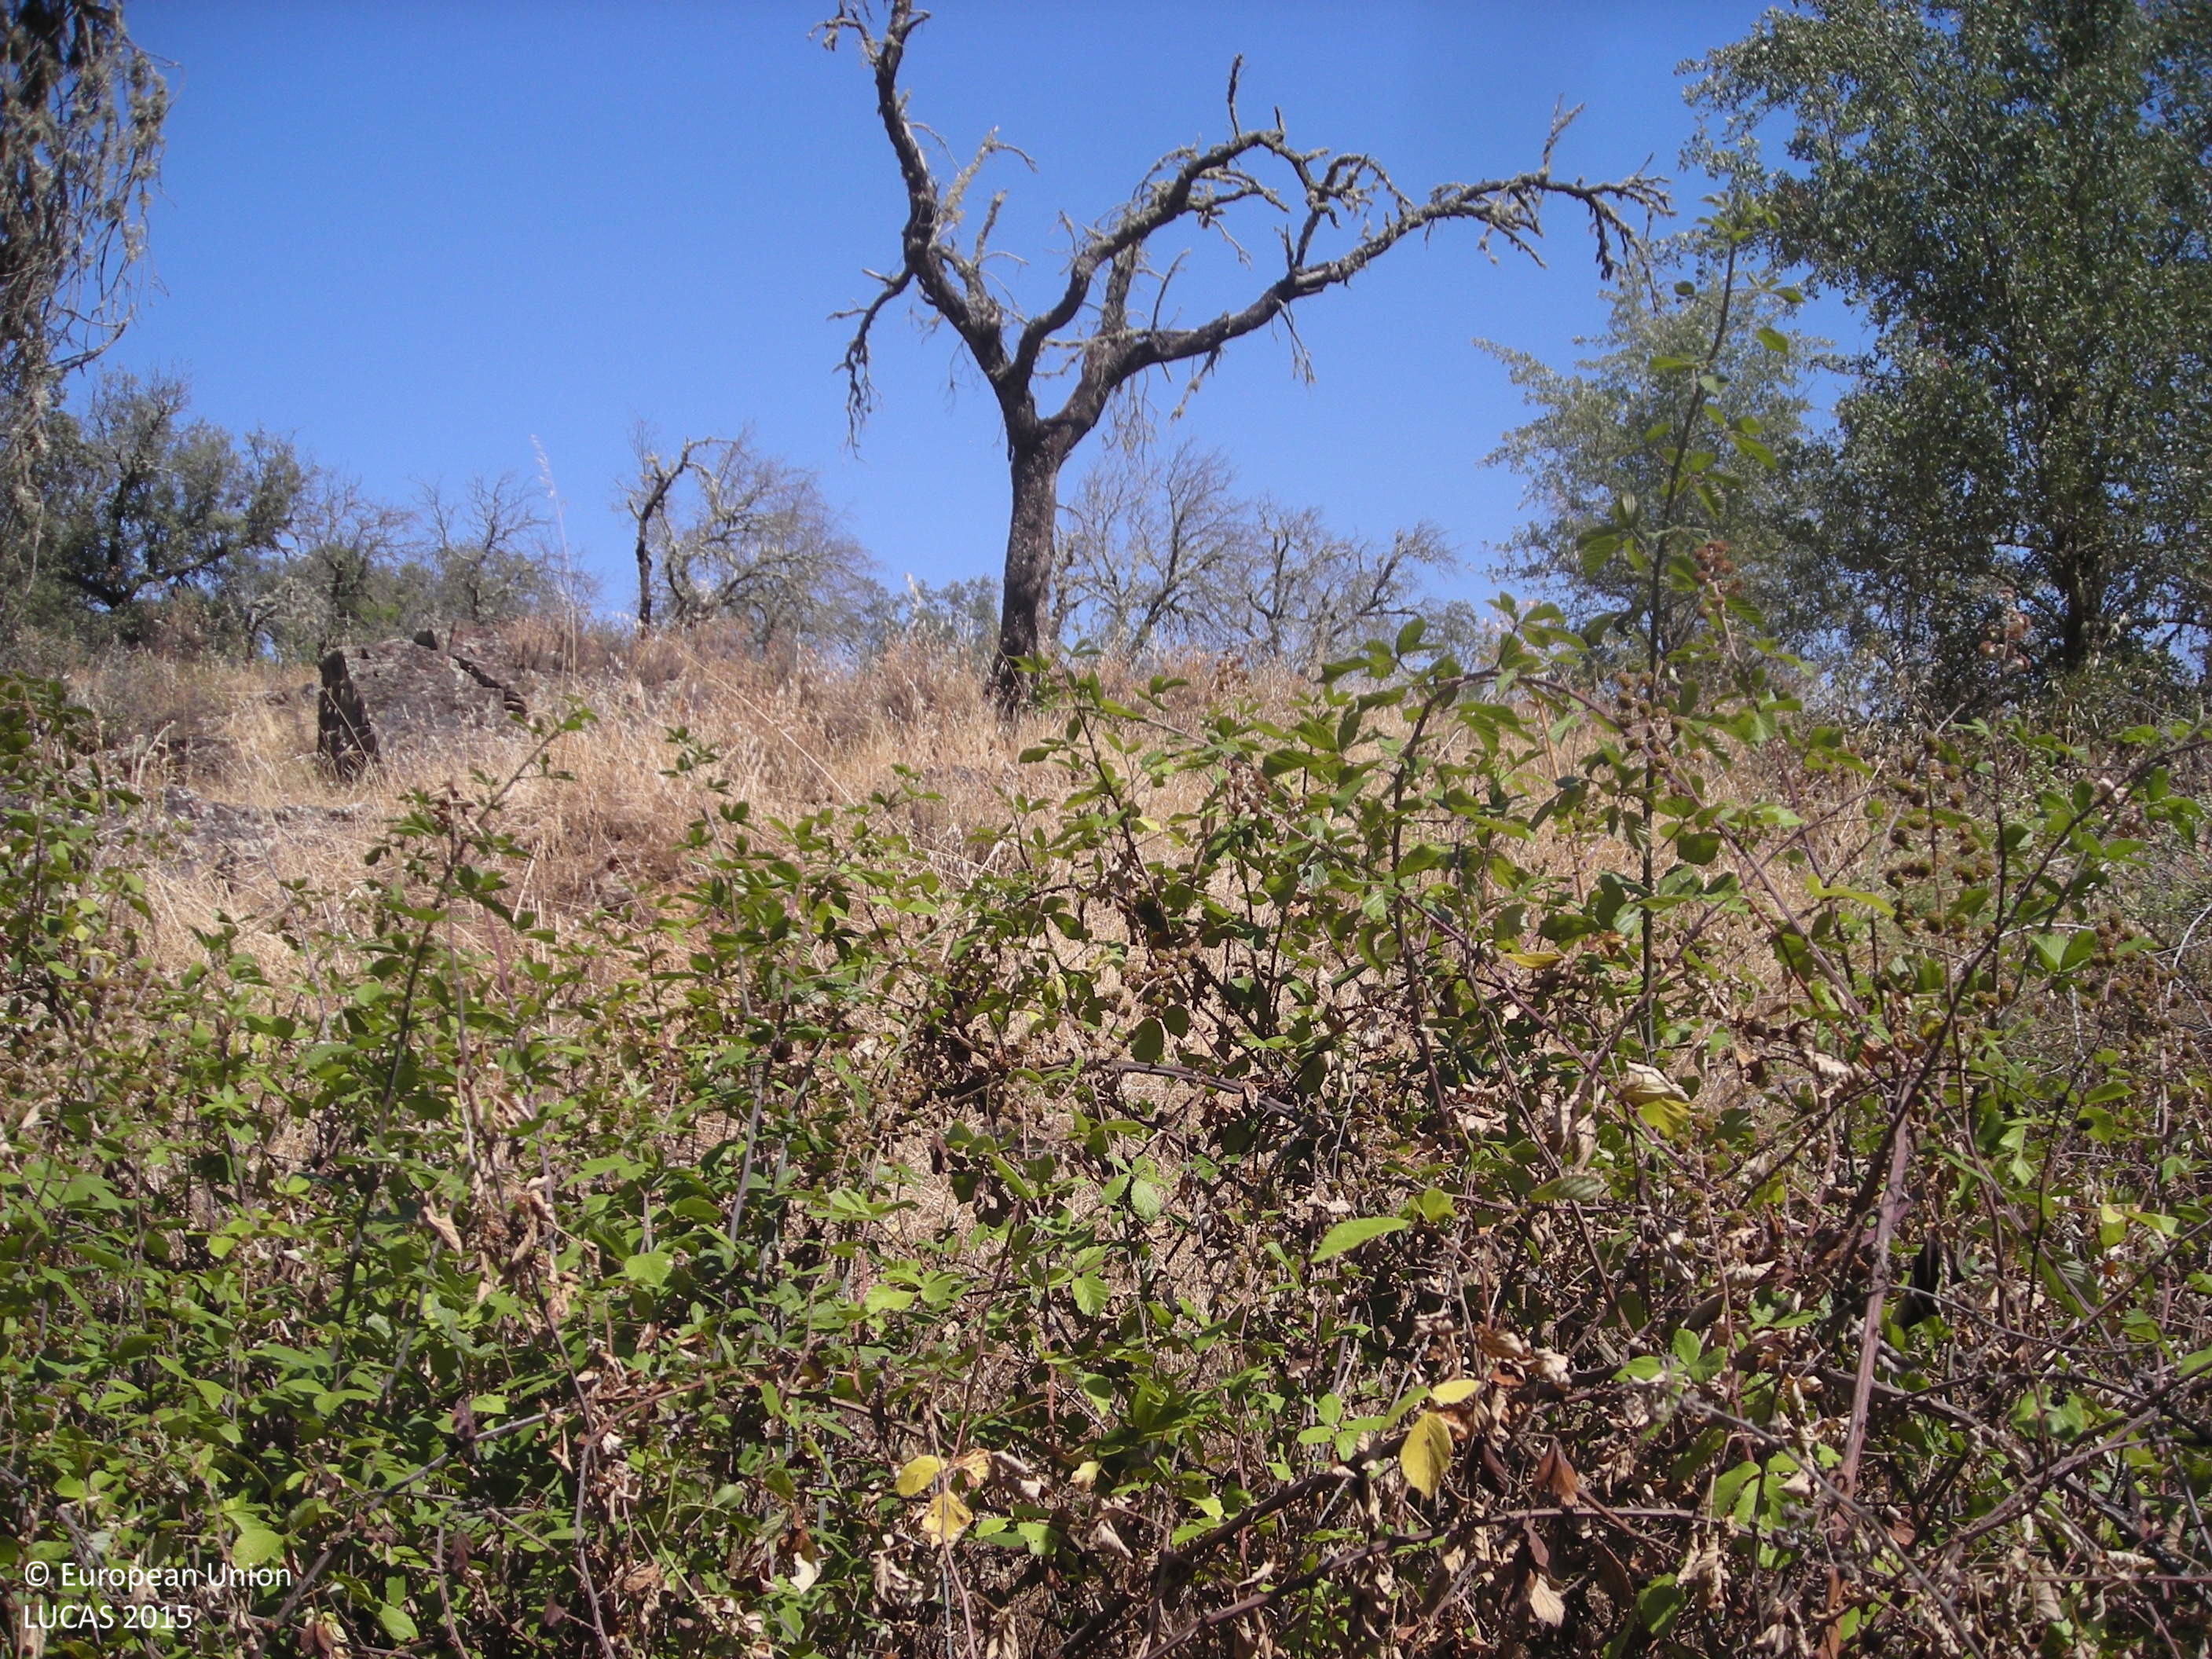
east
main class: Woodland
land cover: Broadleaved woodland
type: broadleaved evergreen forest
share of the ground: 10 - 25 %
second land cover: Grassland without tree/shrub cover
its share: > 75 %
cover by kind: herbaceous plants 90 %, broadleaved forest trees 10 %
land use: Forestry
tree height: > 5 m
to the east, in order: Broadleaved woodland; Grassland without tree/shrub cover; Other structural elements; Fences; Tracks; Broadleaved woodland
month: July
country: ES
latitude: 38.6716
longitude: -5.8715
